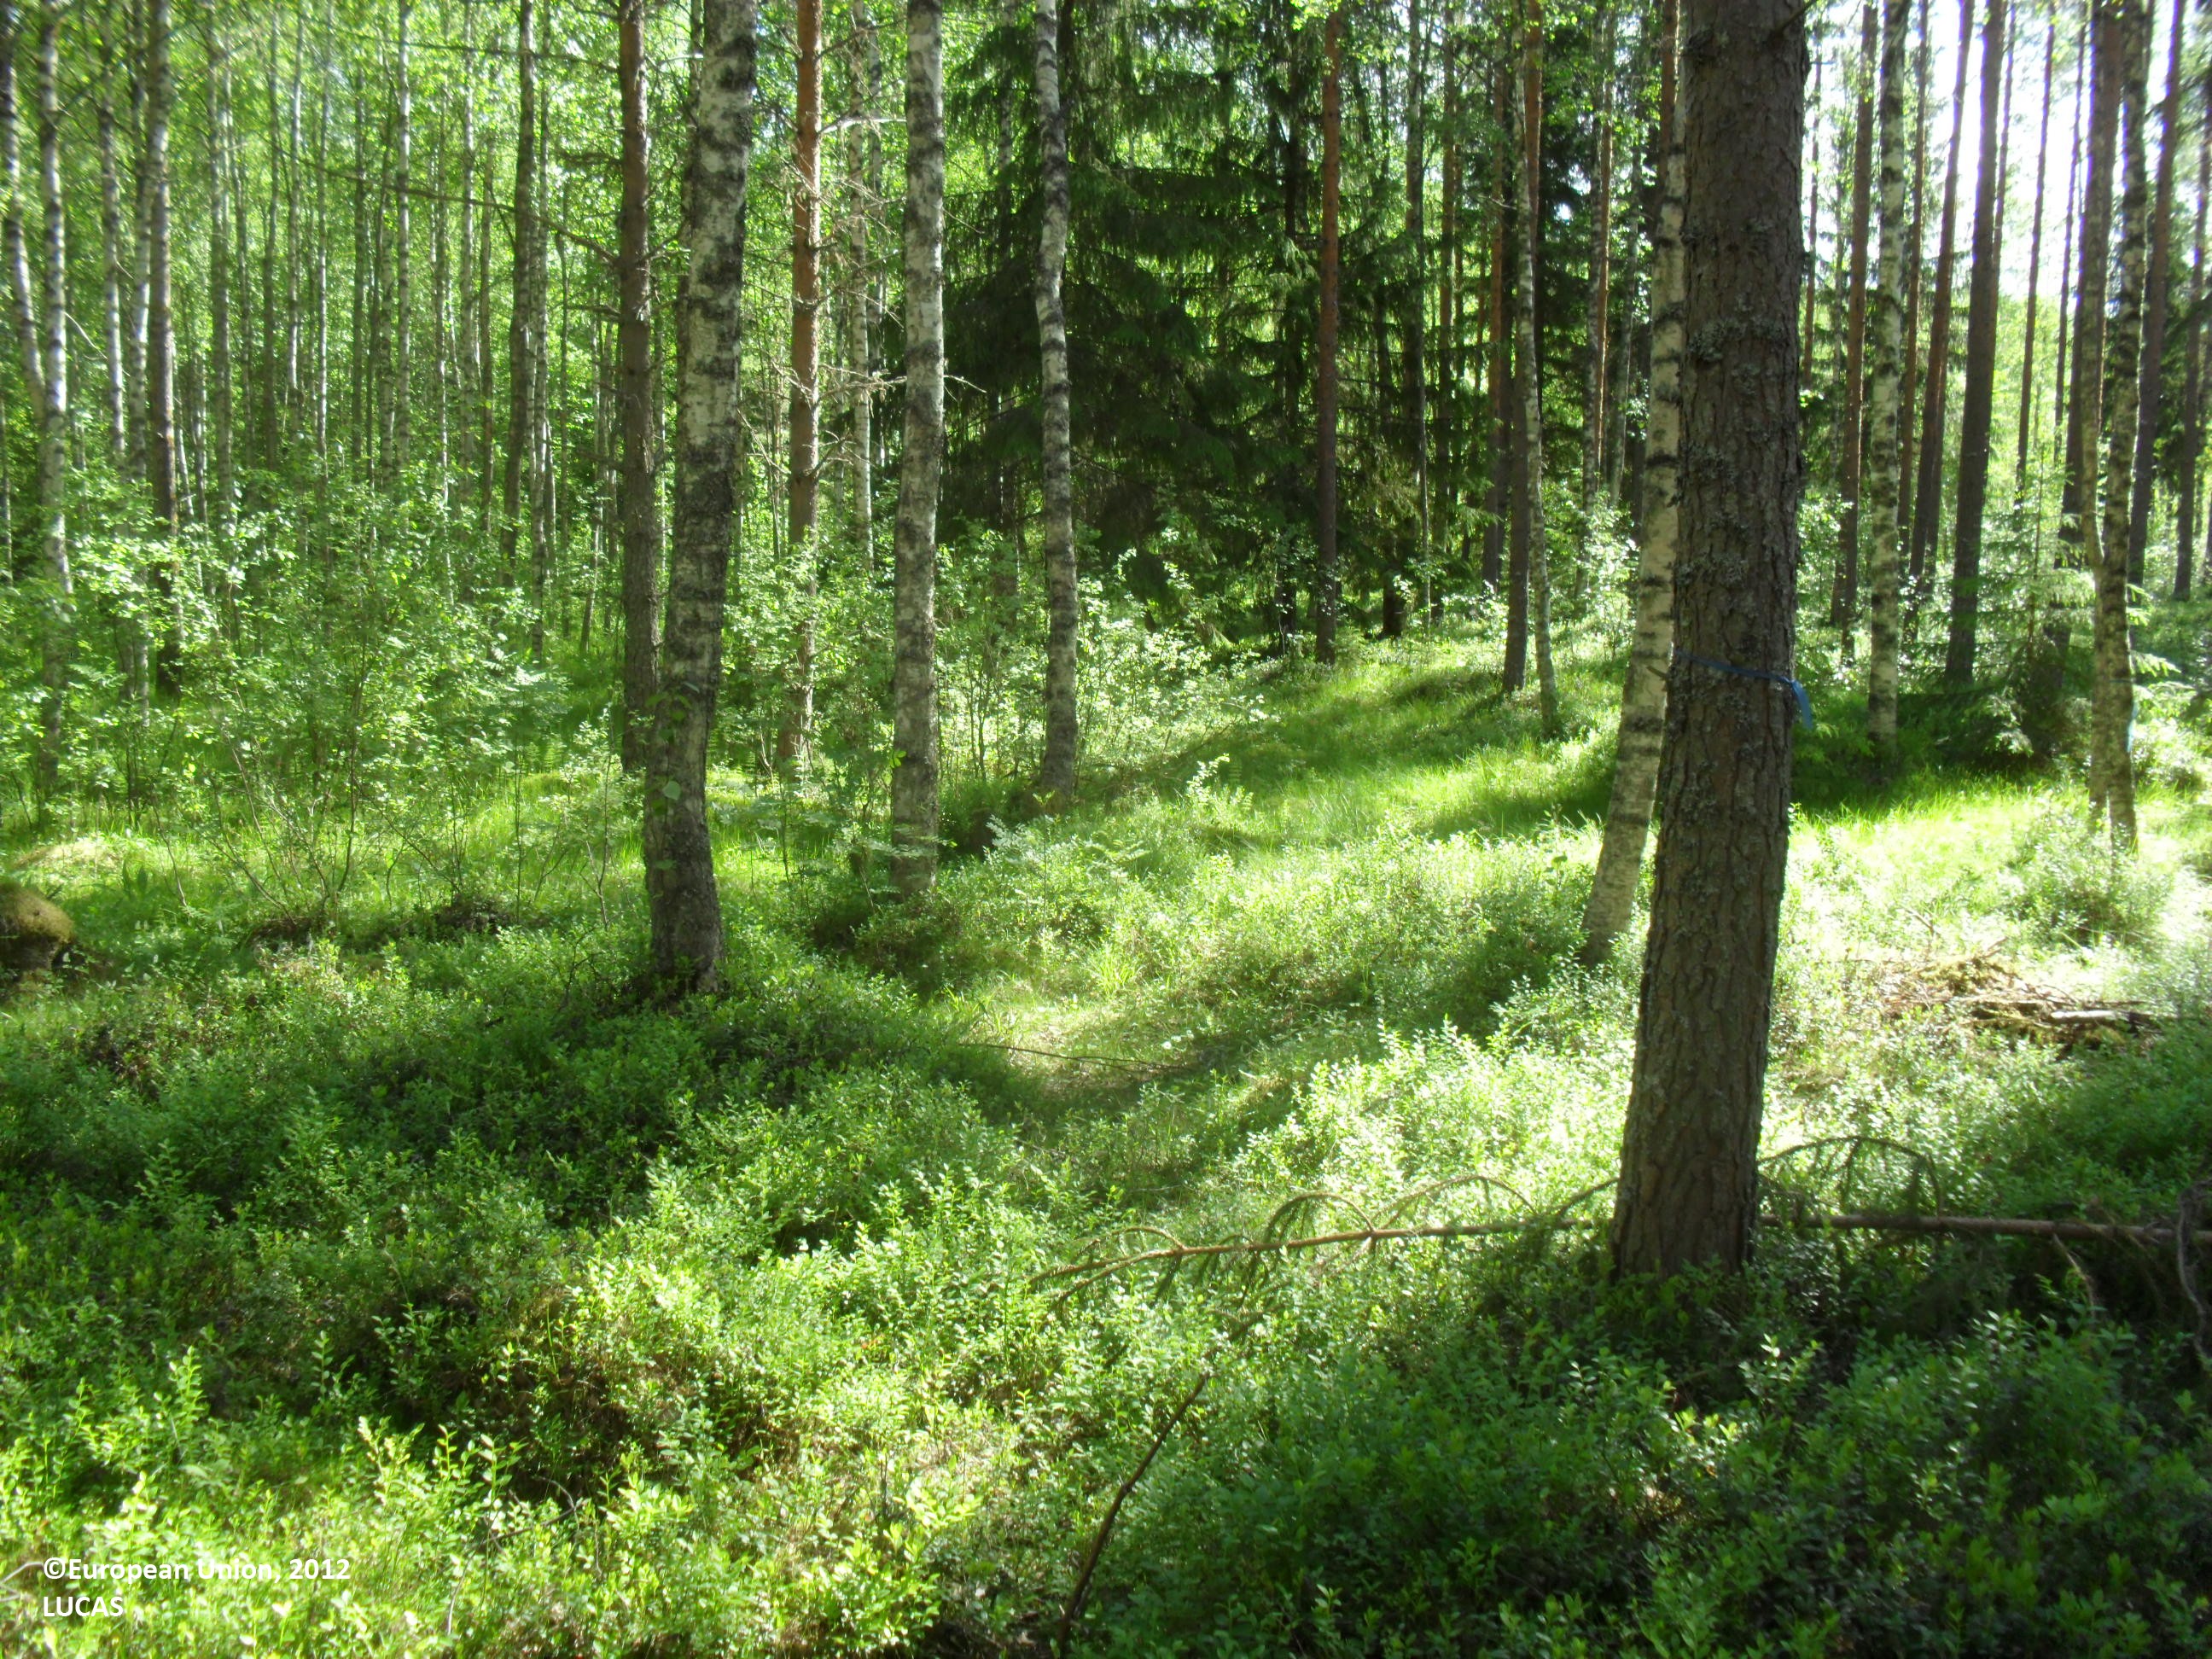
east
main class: Woodland
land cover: Other mixed woodland
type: boreal forest
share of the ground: 25 - 50 %
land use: Forestry
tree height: > 5 m
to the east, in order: Other mixed woodland; Pine dominated mixed woodland; Other mixed woodland; Broadleaved woodland; Other mixed woodland; Pine dominated coniferous woodland; Lichens and moss; Pine dominated coniferous woodland; Spruce dominated coniferous woodland; Ditches and canals; Other mixed woodland
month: June
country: FI
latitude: 63.2248
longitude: 22.9289
